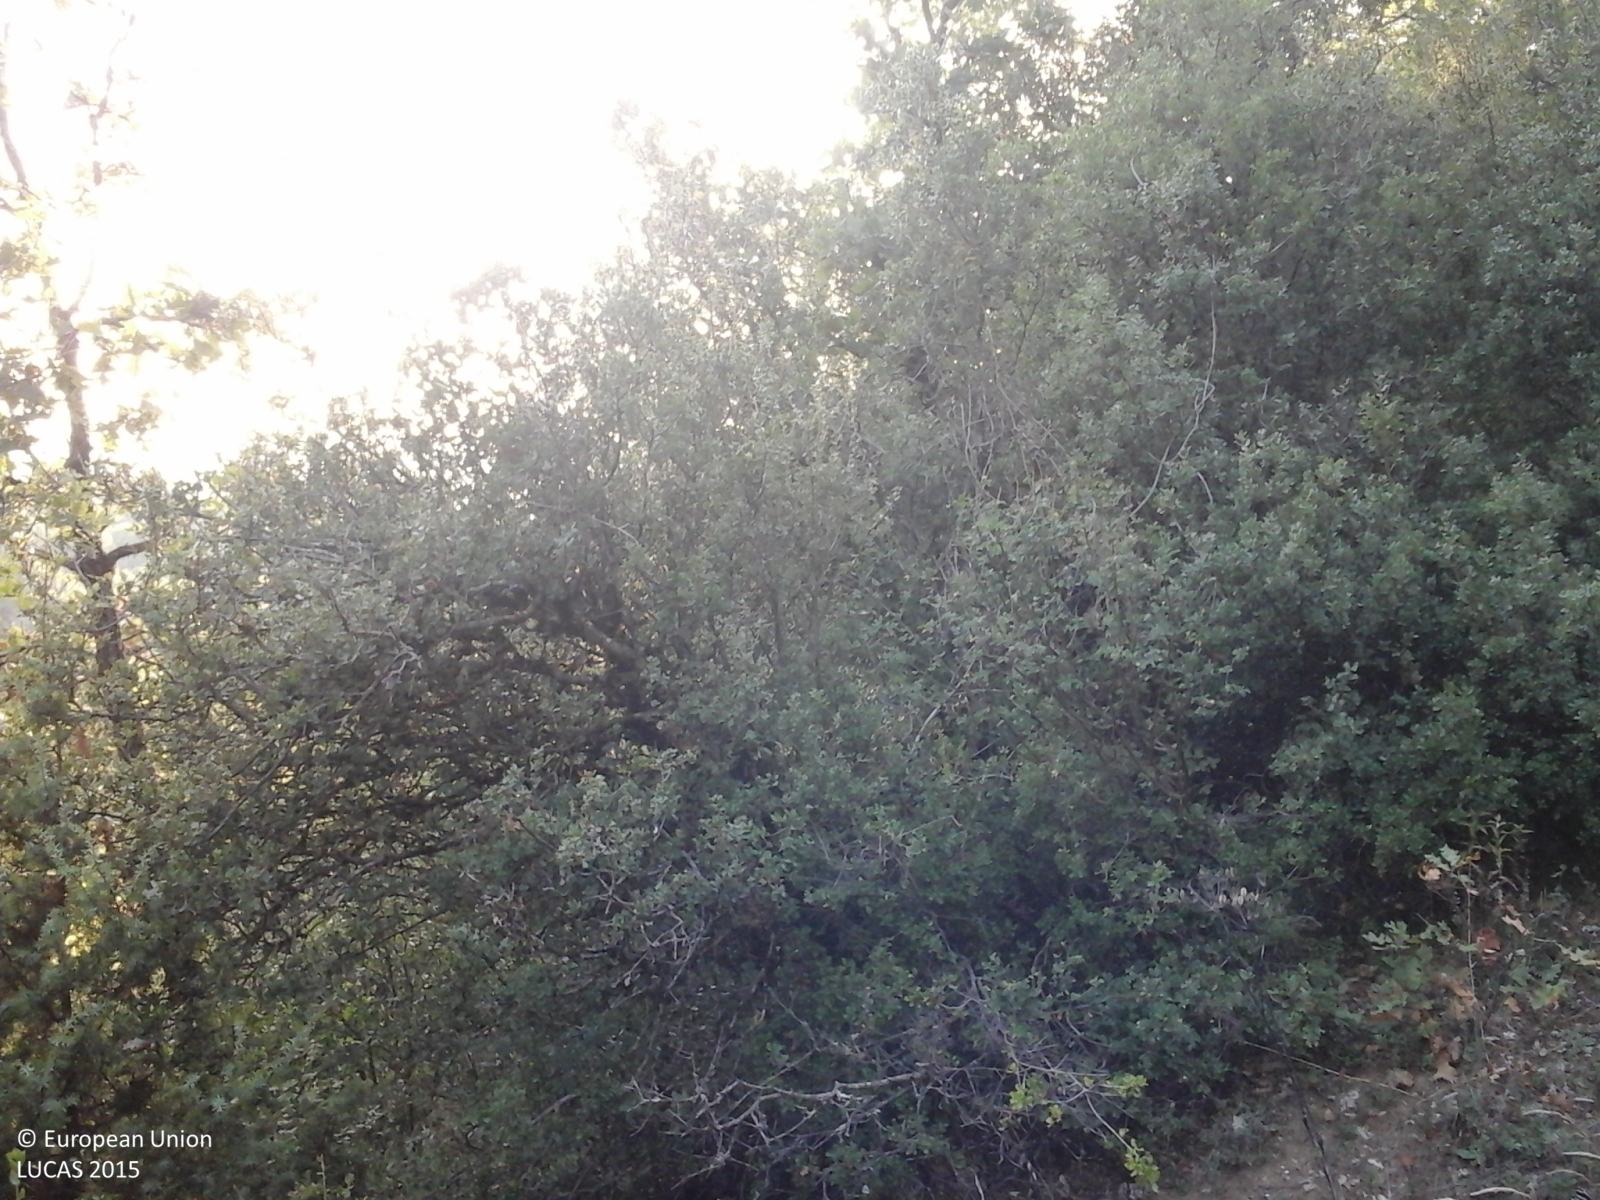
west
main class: Woodland
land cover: Broadleaved woodland
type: thermophilous deciduous forest
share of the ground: 25 - 50 %
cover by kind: shrubs 55 %, broadleaved forest trees 30 %, herbaceous plants 10 %, unconsolidated bare surface 5 %
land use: Semi-natural and natural areas not in use
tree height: > 5 m
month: September
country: GR
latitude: 39.9703
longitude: 20.7173
